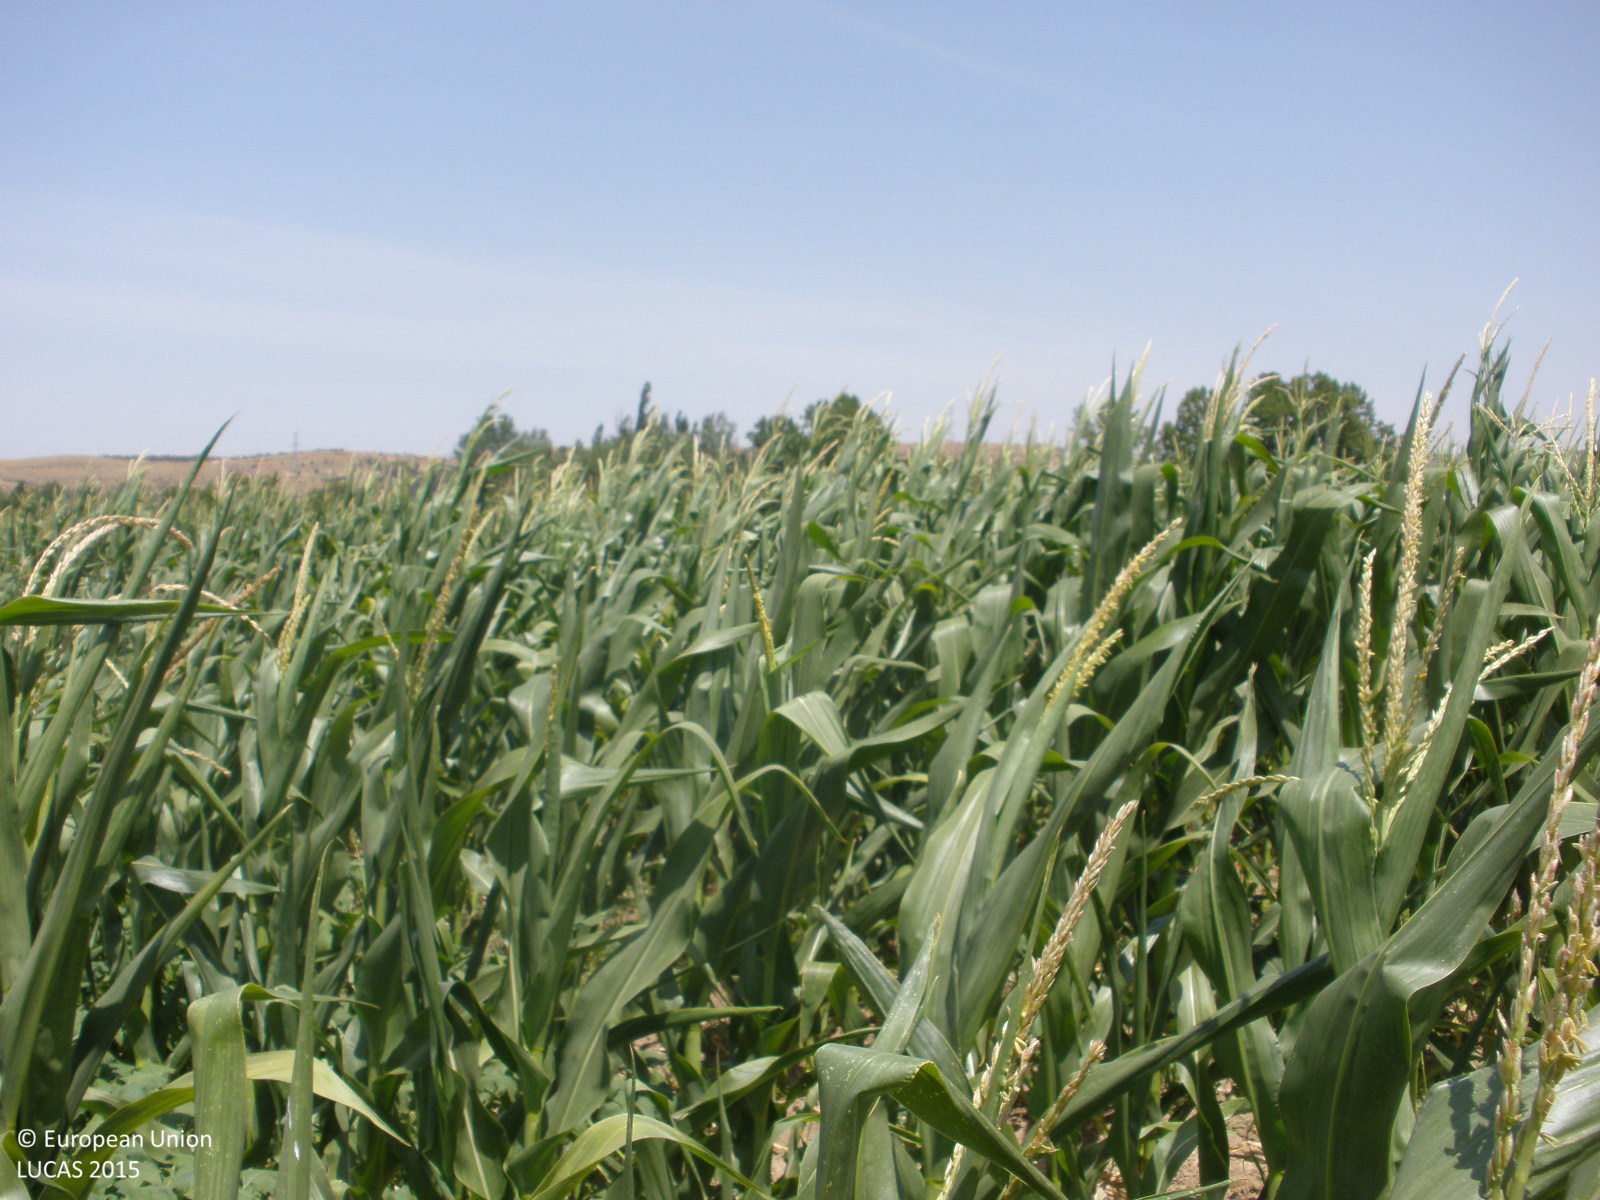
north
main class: Cropland
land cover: Maize
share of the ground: > 75 %
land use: Agriculture (excluding fallow land and kitchen gardens)
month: July
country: ES
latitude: 40.2171
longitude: -3.4389
